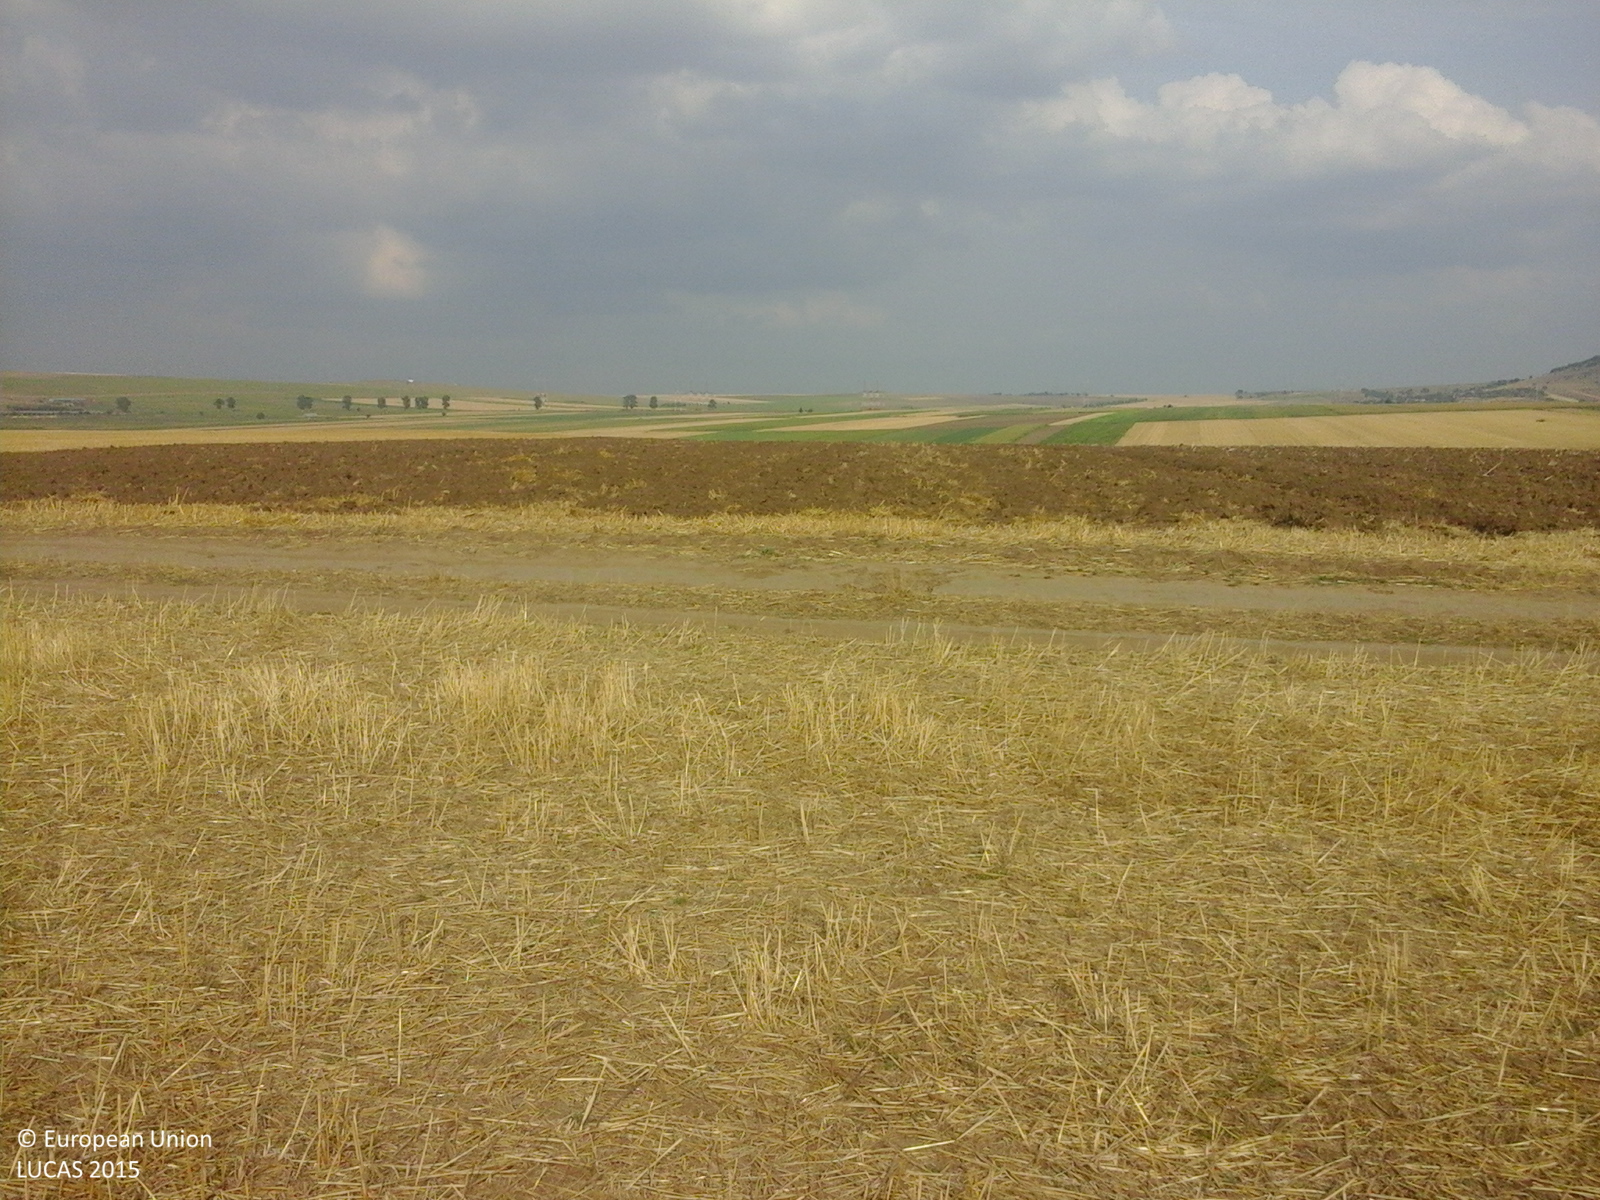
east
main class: Cropland
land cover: Common wheat
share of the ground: 50 - 75 %
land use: Agriculture (excluding fallow land and kitchen gardens)
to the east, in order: Common wheat; Tracks; Other bare soil
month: July
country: RO
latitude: 45.0252
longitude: 28.3360
